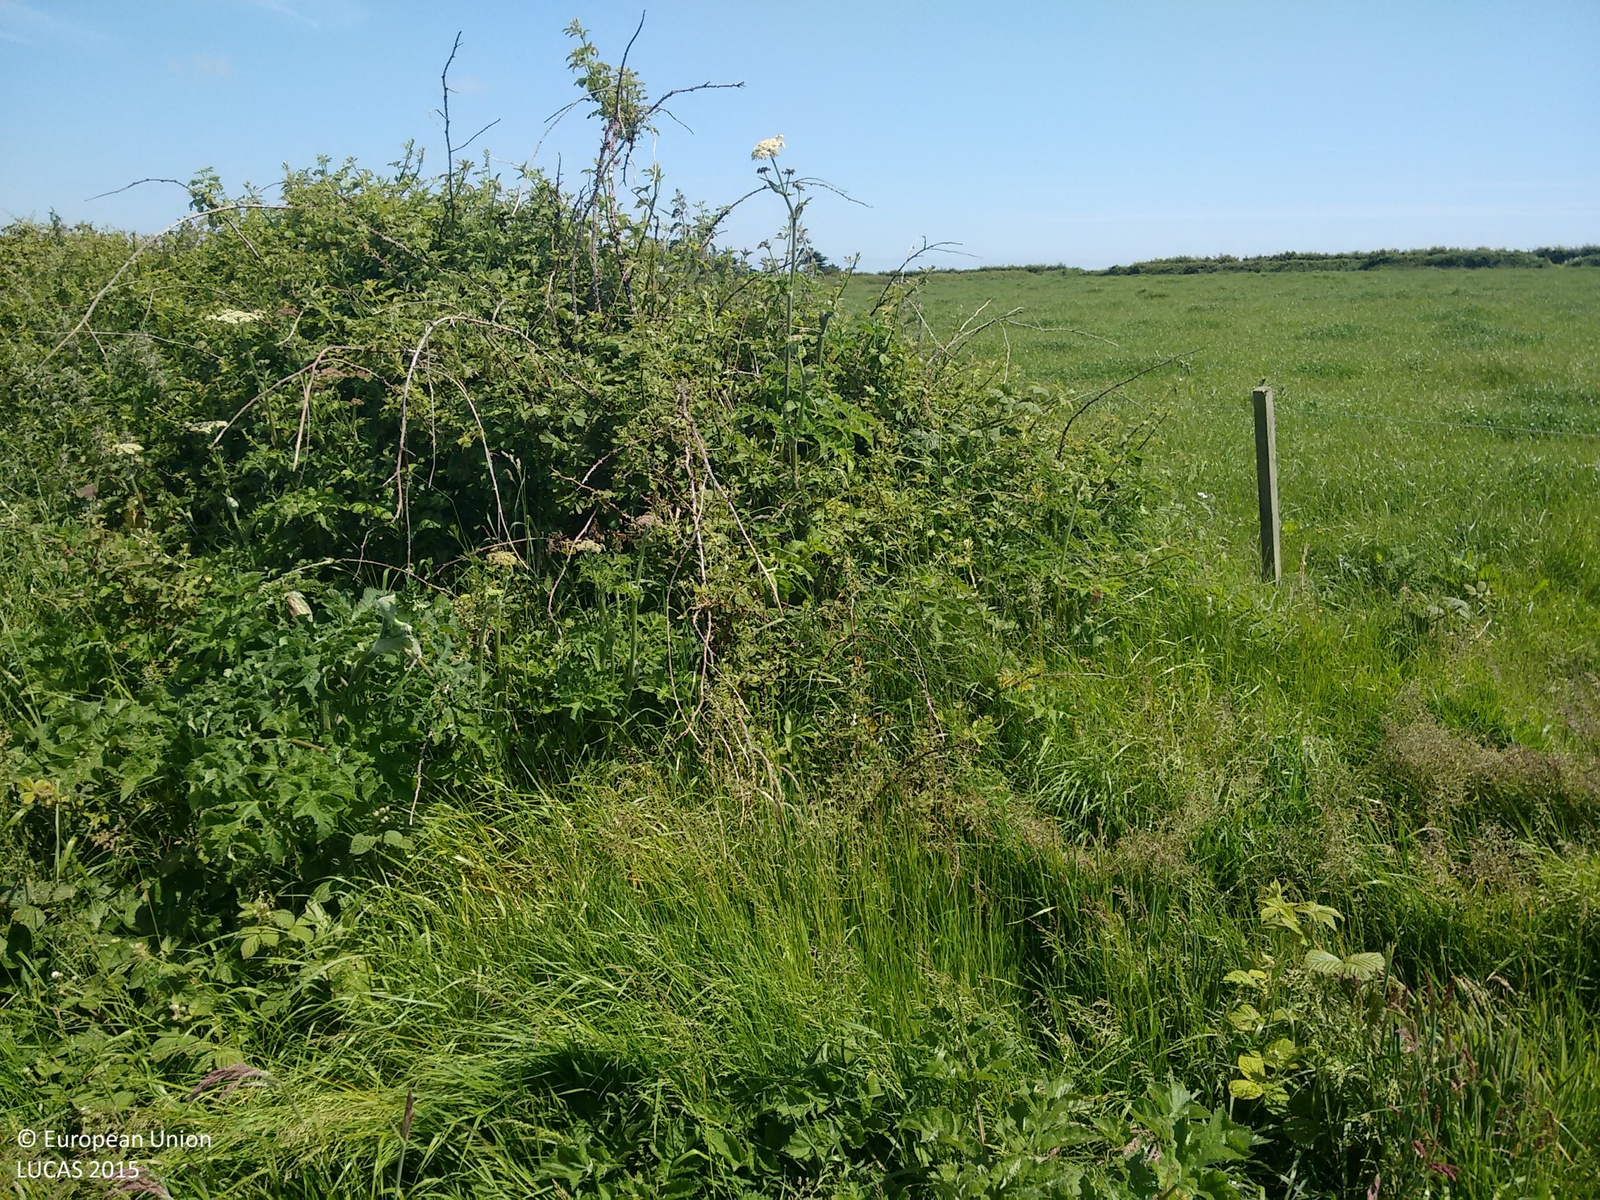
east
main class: Cropland
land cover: Common wheat
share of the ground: > 75 %
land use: Agriculture (excluding fallow land and kitchen gardens)
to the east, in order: Common wheat; Abandoned hedges; Fences; Grassland without tree/shrub cover; Fences; Abandoned hedges; Fences; Grassland without tree/shrub cover
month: June
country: IE
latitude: 51.8790
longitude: -8.0605
